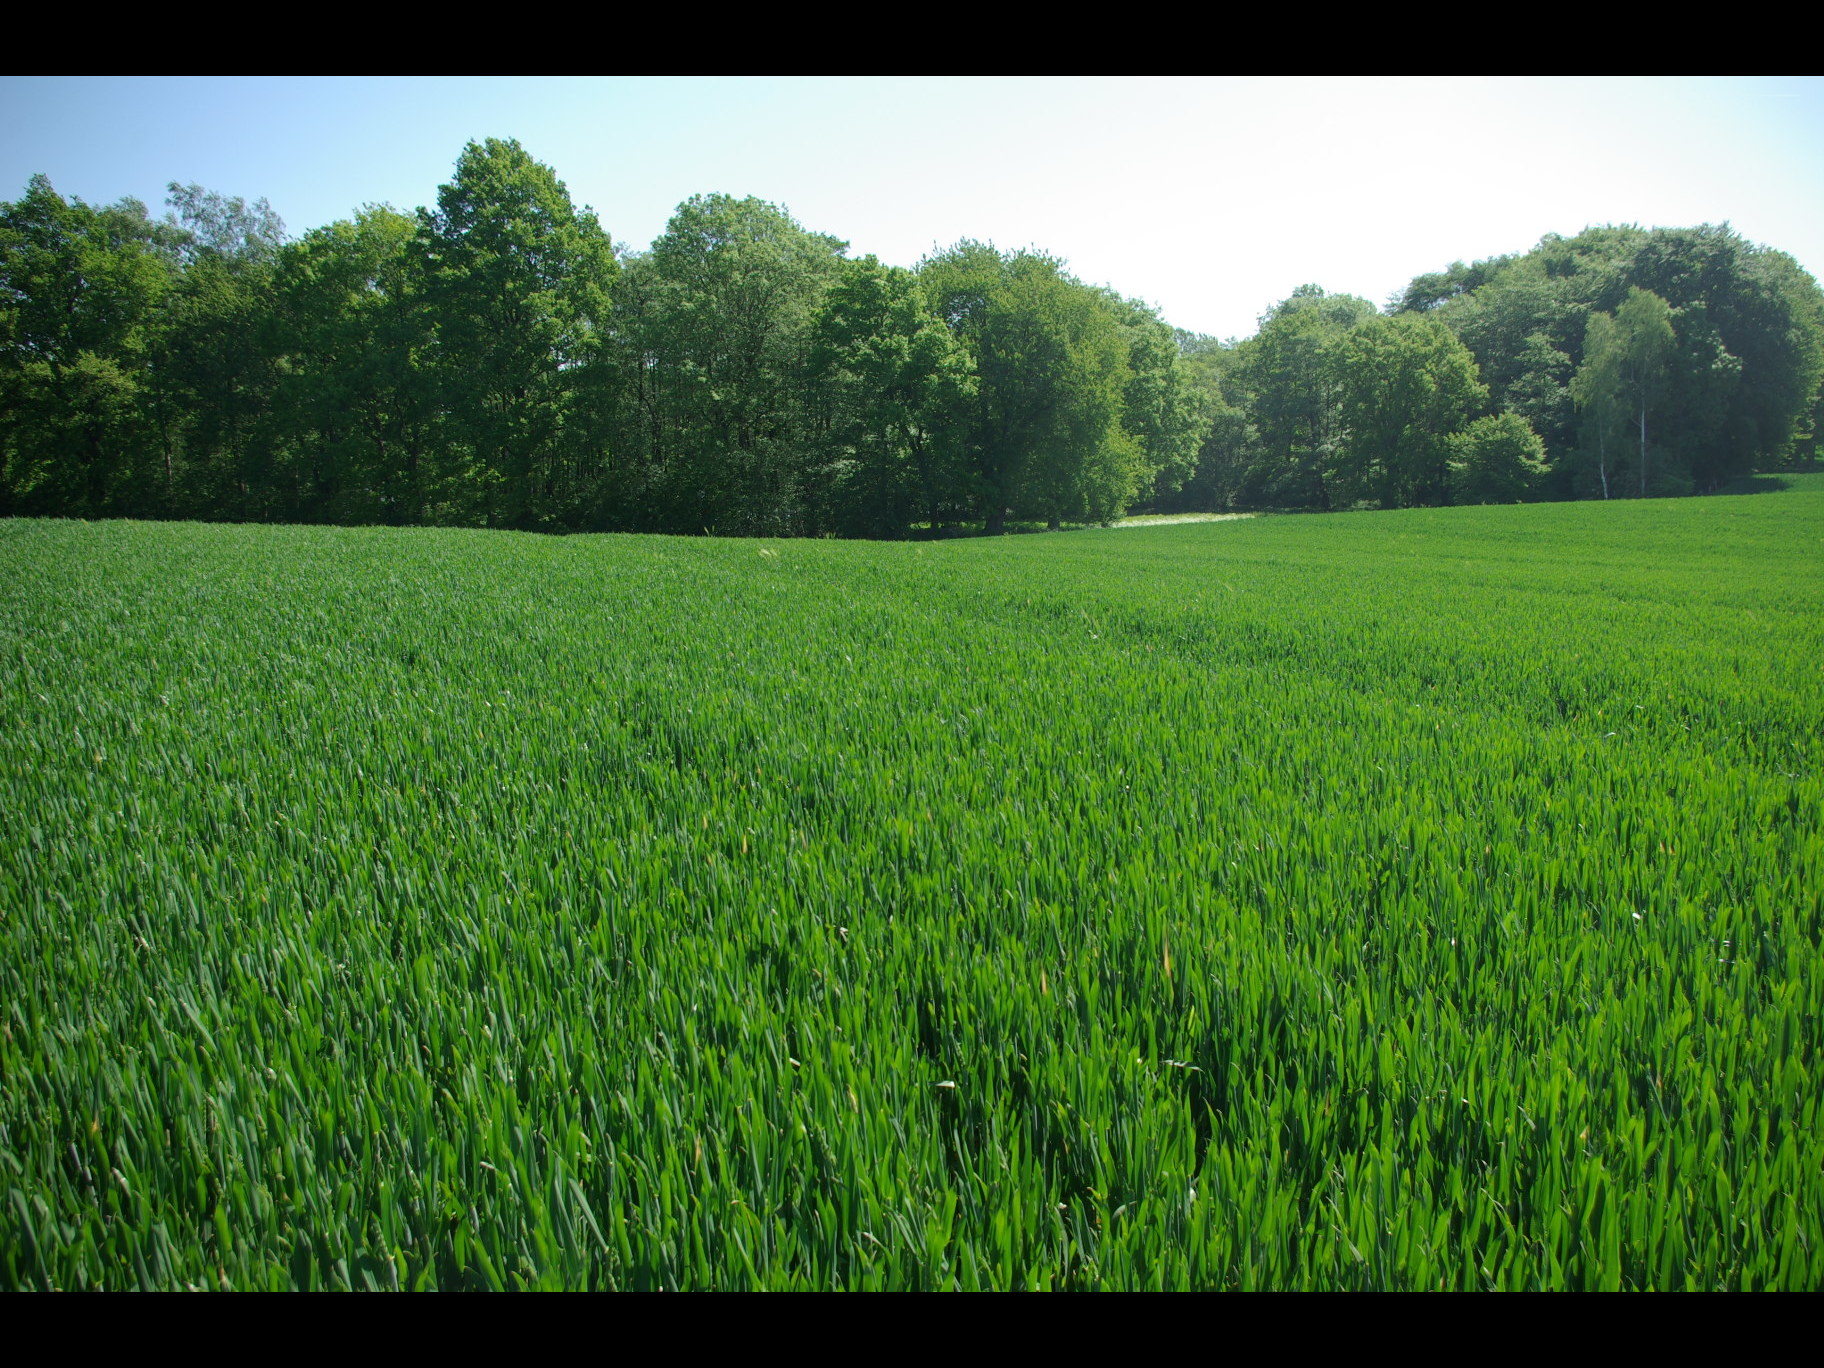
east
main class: Cropland
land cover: Common wheat
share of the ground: > 75 %
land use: Agriculture (excluding fallow land and kitchen gardens)
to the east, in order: Common wheat; Broadleaved woodland; Fences; Spontaneously vegetated surfaces; Fences; Broadleaved woodland; Inland fresh water bodies
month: June
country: DE
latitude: 54.1911
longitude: 10.6280
